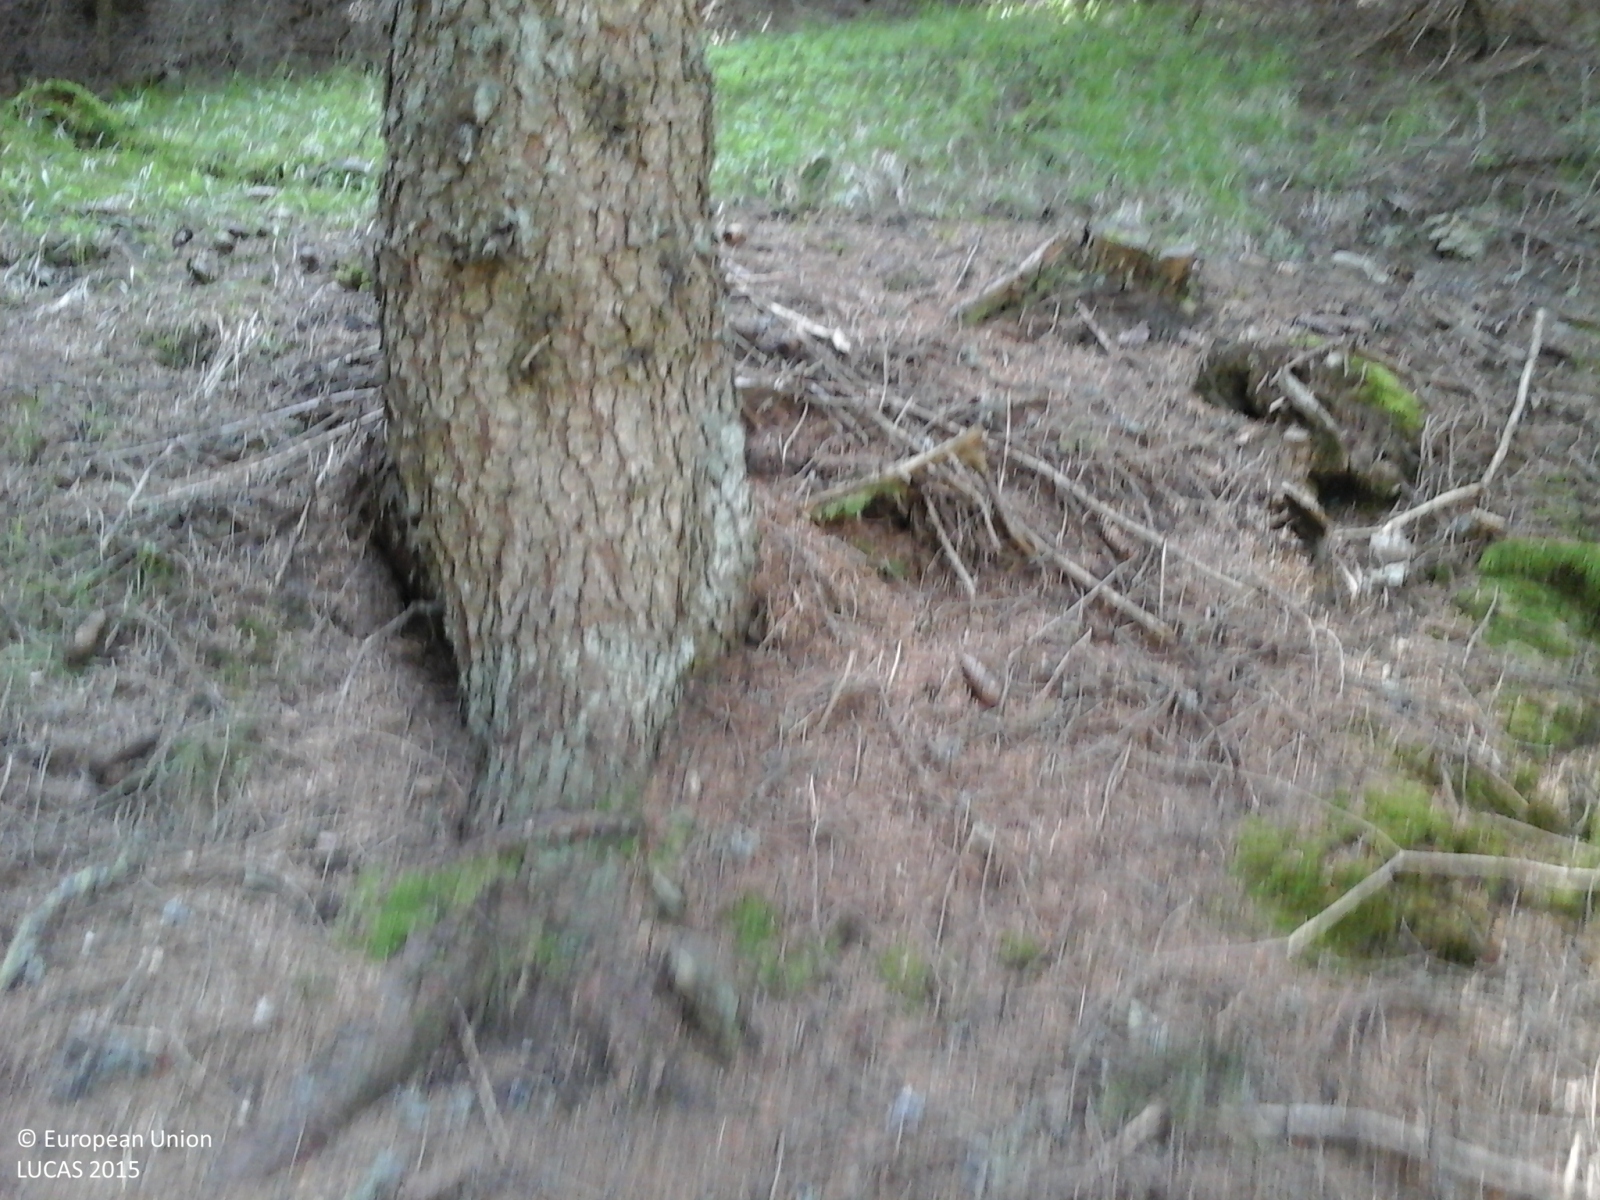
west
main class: Woodland
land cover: Spruce dominated coniferous woodland
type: alpine coniferous forest
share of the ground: > 75 %
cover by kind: coniferous forest trees 100 %
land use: Forestry
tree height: > 5 m
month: June
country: IT
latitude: 46.6517
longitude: 11.1093
